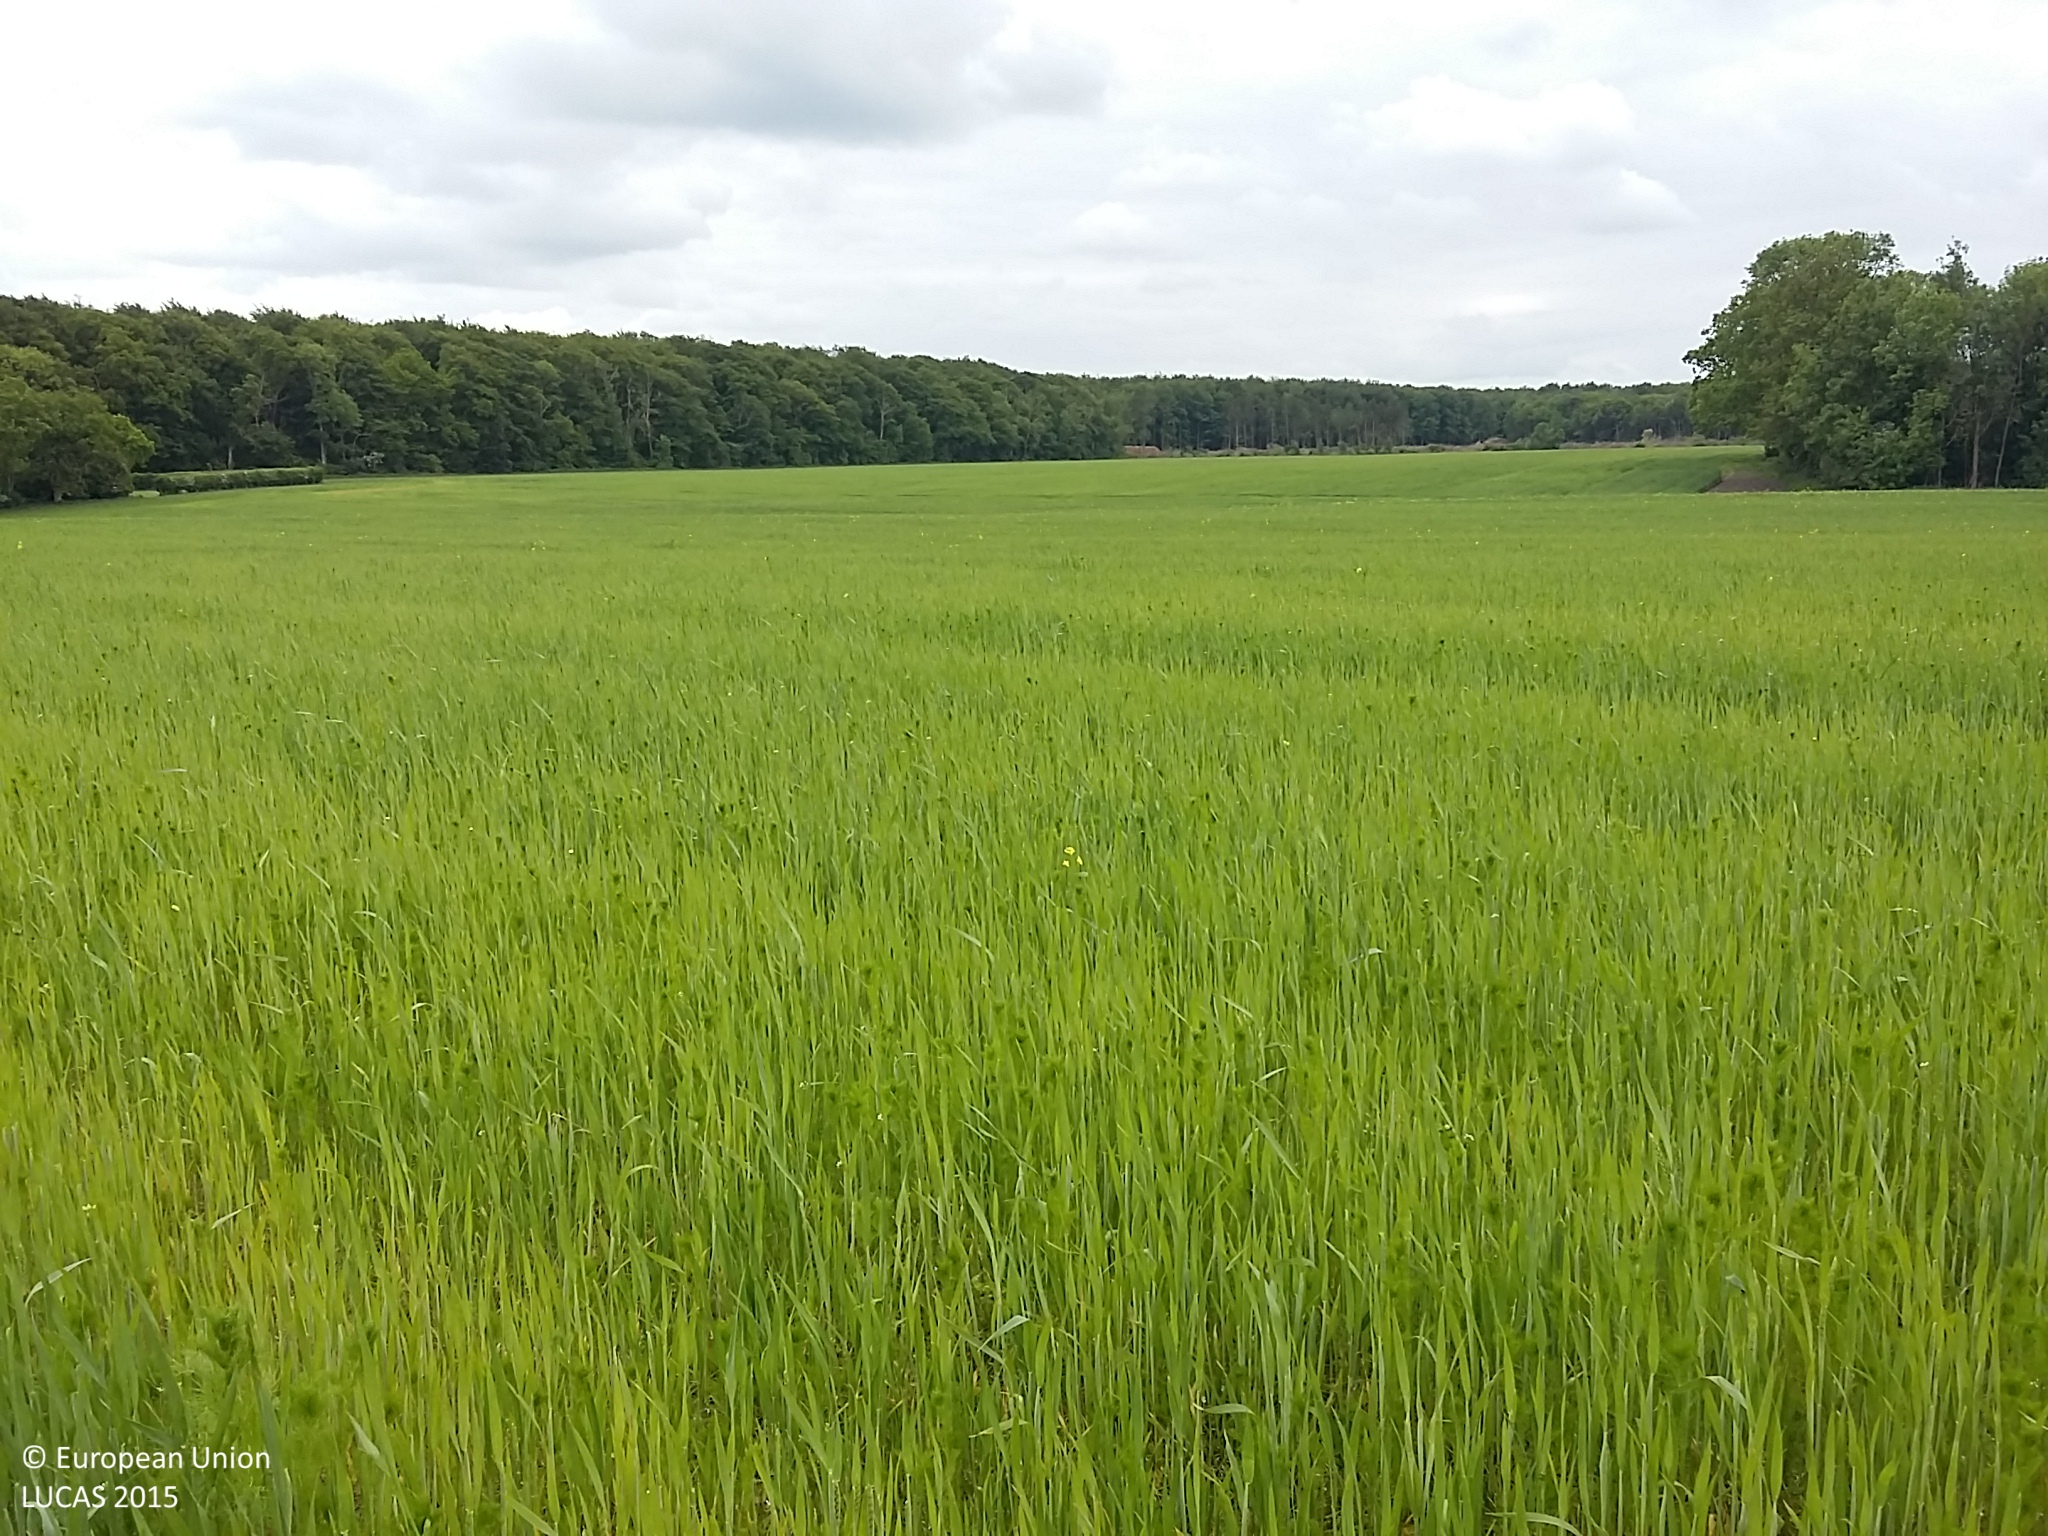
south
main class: Cropland
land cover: Common wheat
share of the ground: > 75 %
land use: Agriculture (excluding fallow land and kitchen gardens)
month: June
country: DK
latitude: 55.4310
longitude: 10.6789
